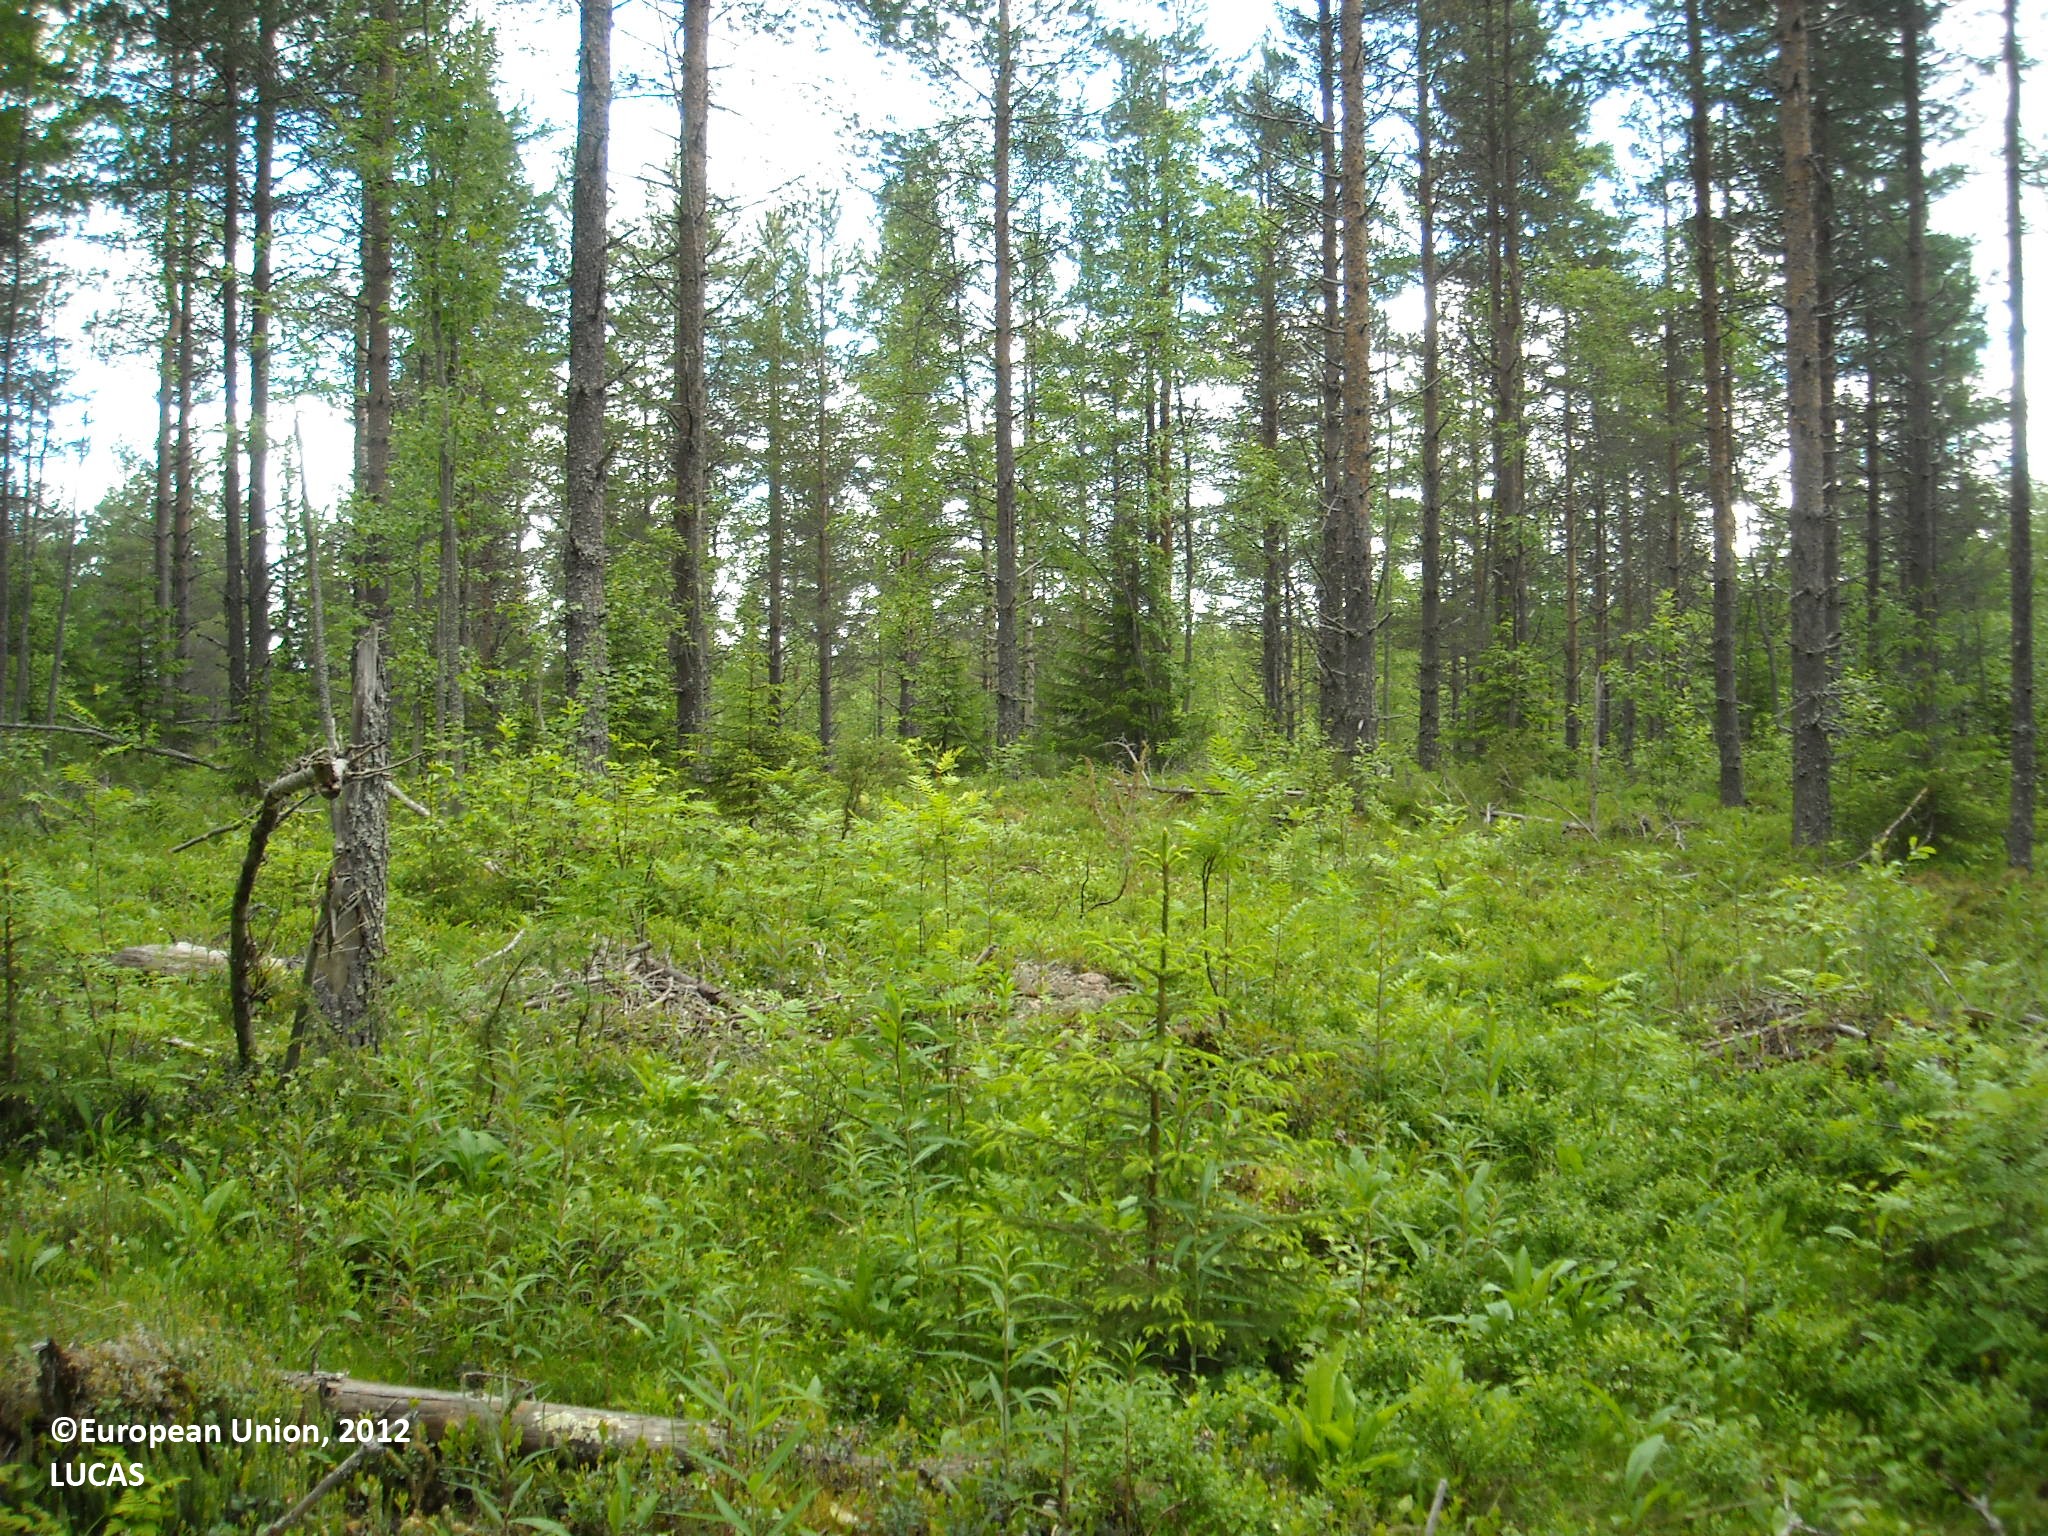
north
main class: Woodland
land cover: Pine dominated coniferous woodland
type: boreal forest
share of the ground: 25 - 50 %
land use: Forestry
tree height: > 5 m
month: June
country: FI
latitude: 64.7281
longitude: 27.8920
